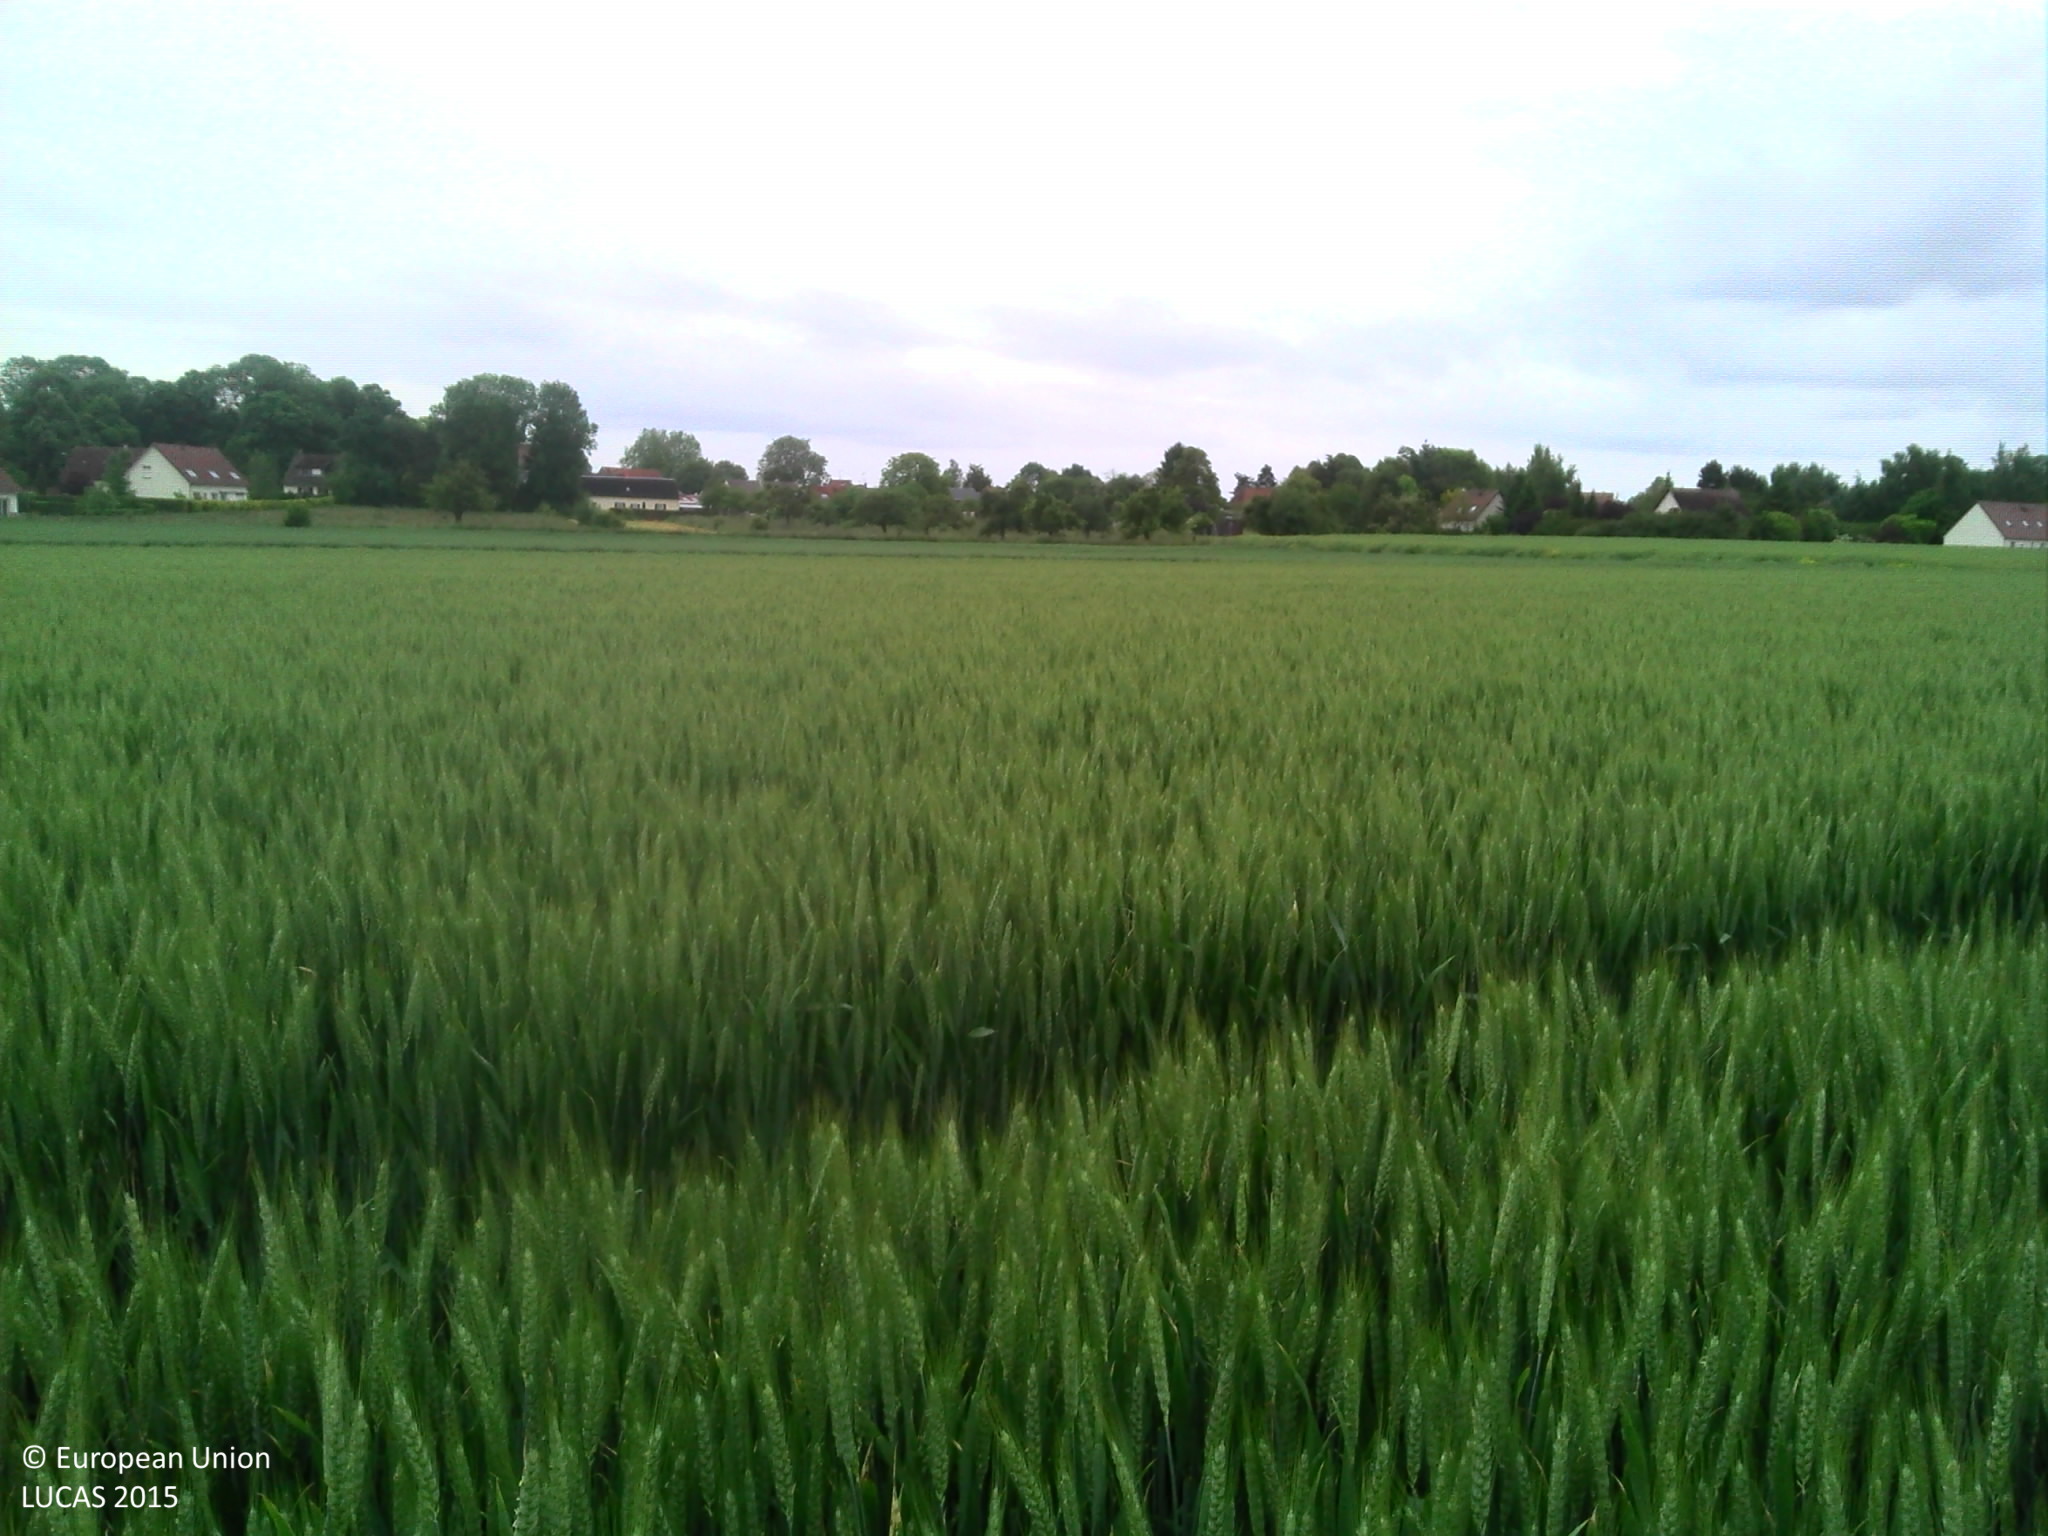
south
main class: Cropland
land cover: Durum wheat
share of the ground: > 75 %
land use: Agriculture (excluding fallow land and kitchen gardens)
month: June
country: FR
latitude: 49.8971
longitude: 2.1759
